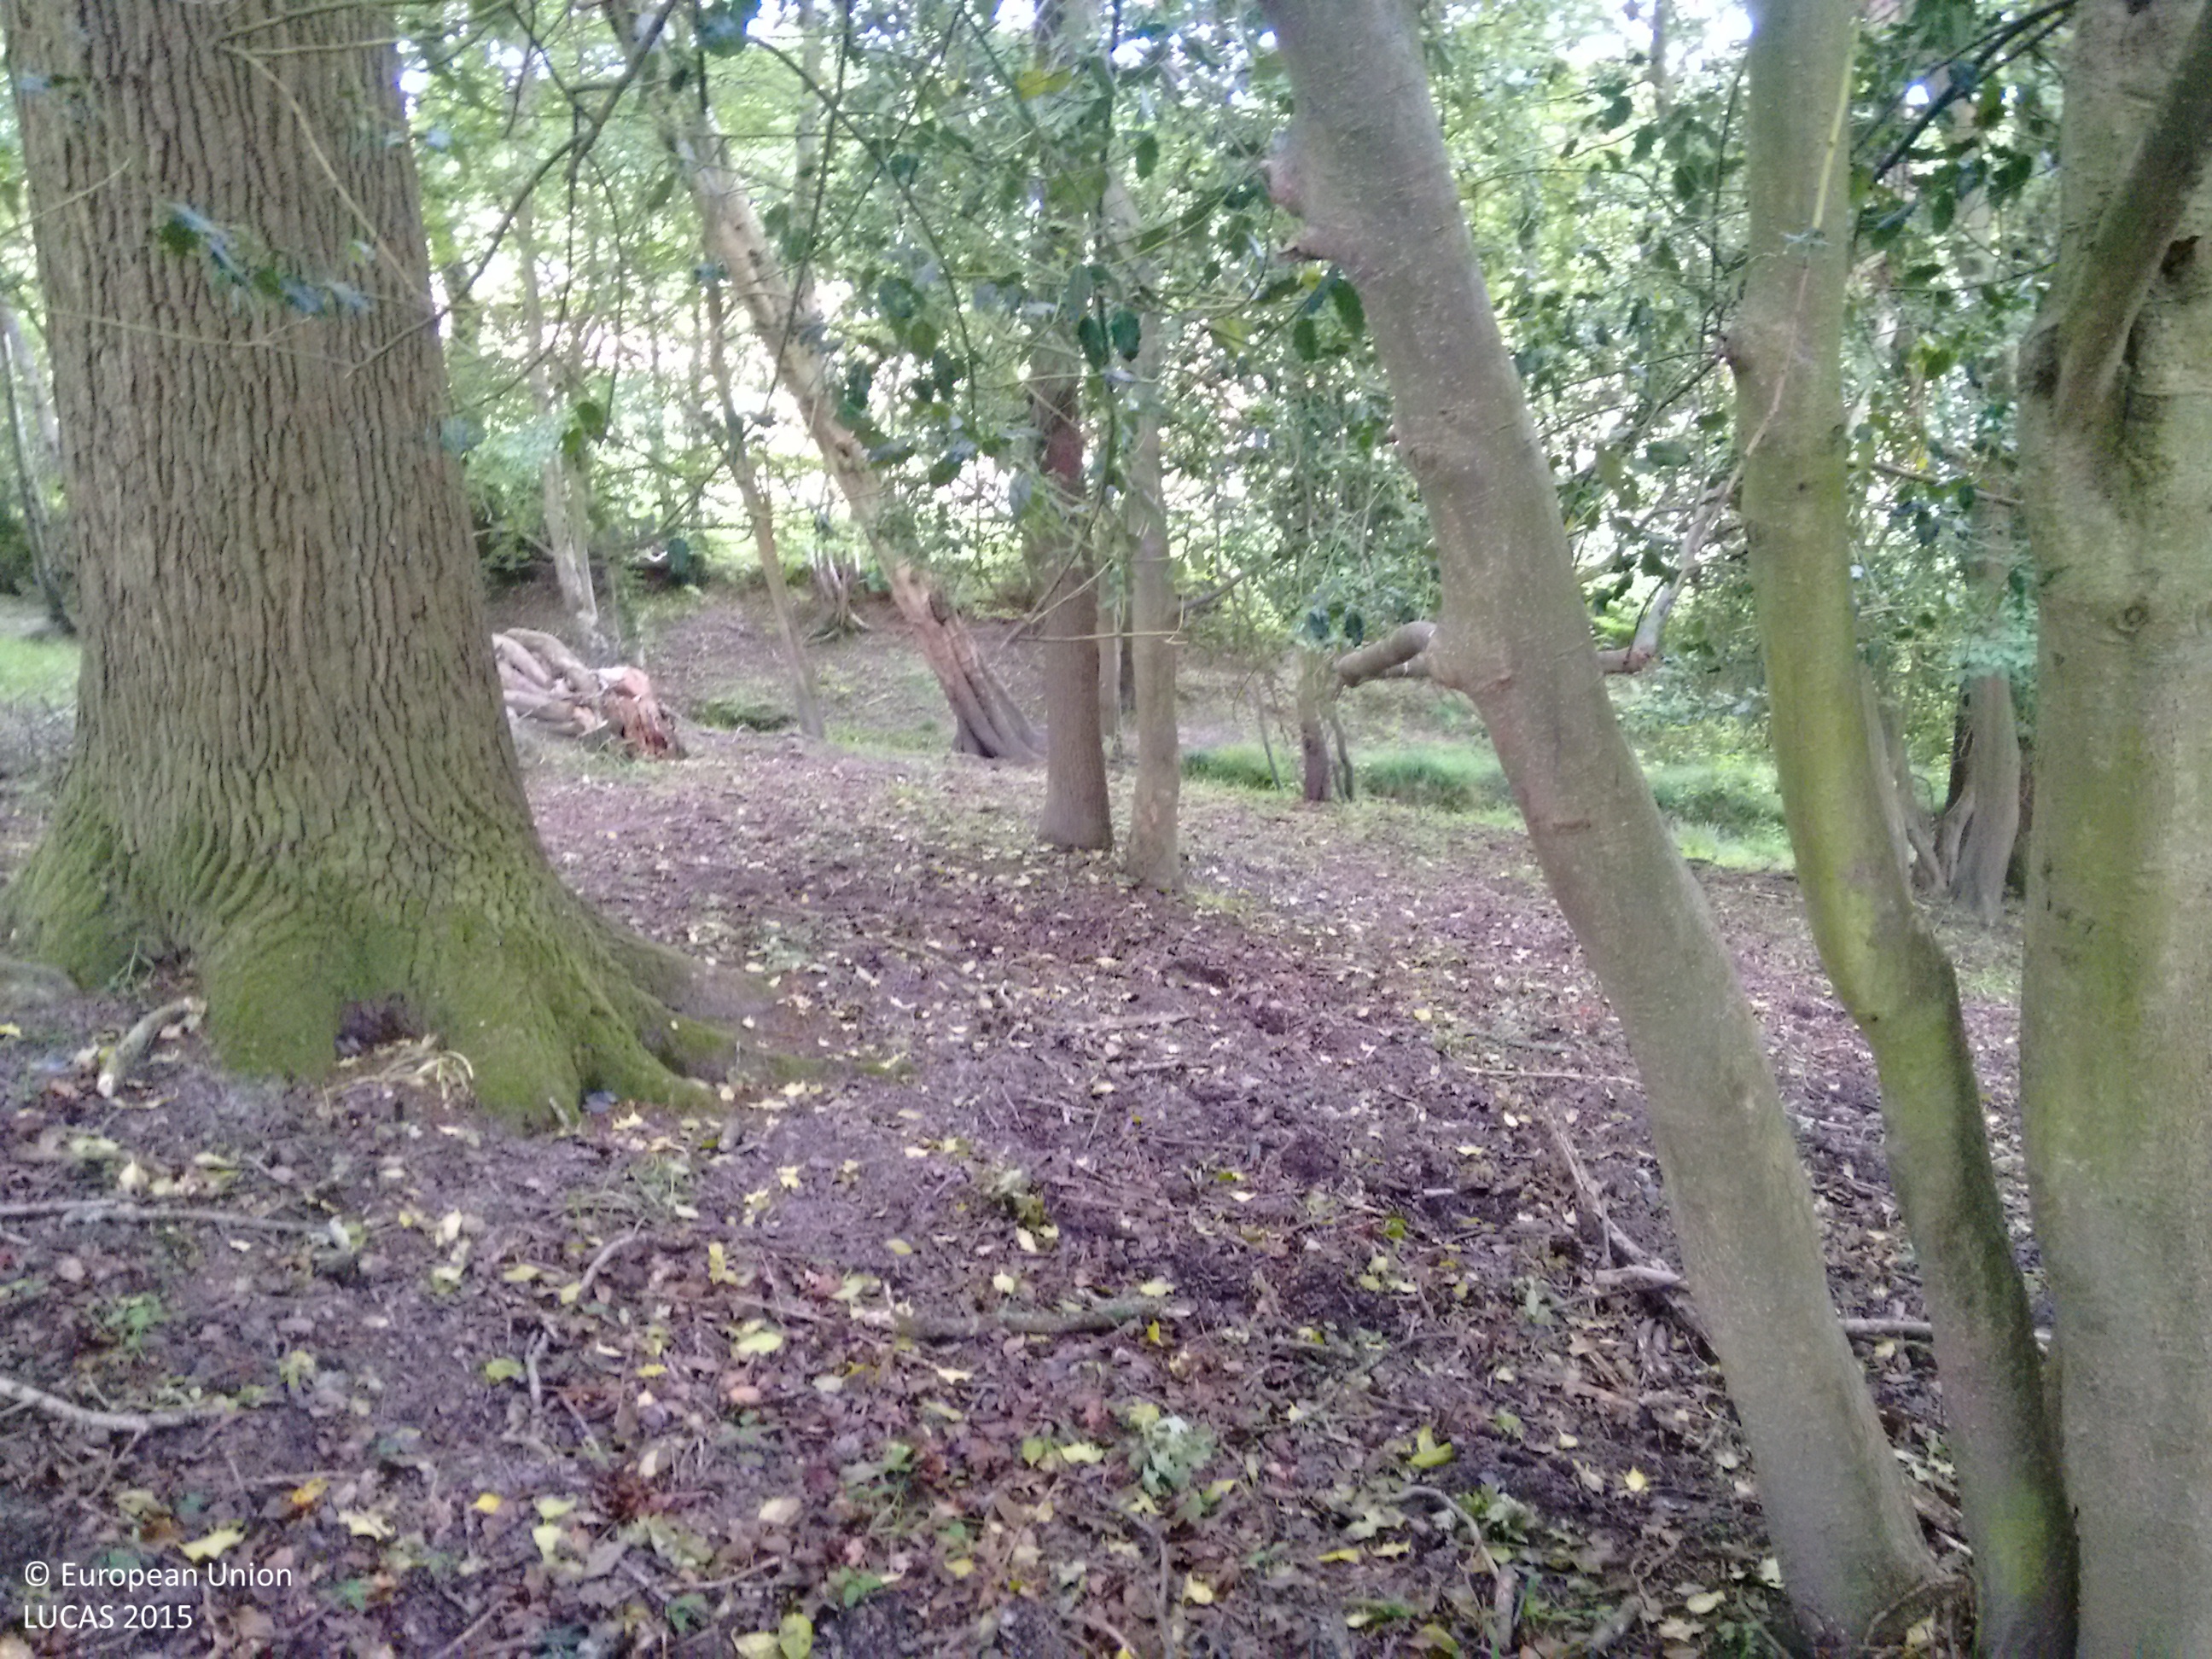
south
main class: Woodland
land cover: Broadleaved woodland
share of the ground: > 75 %
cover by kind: broadleaved forest trees 90 %, shrubs 10 %
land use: Semi-natural and natural areas not in use
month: June
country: GB
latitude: 50.9523
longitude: 0.3622
